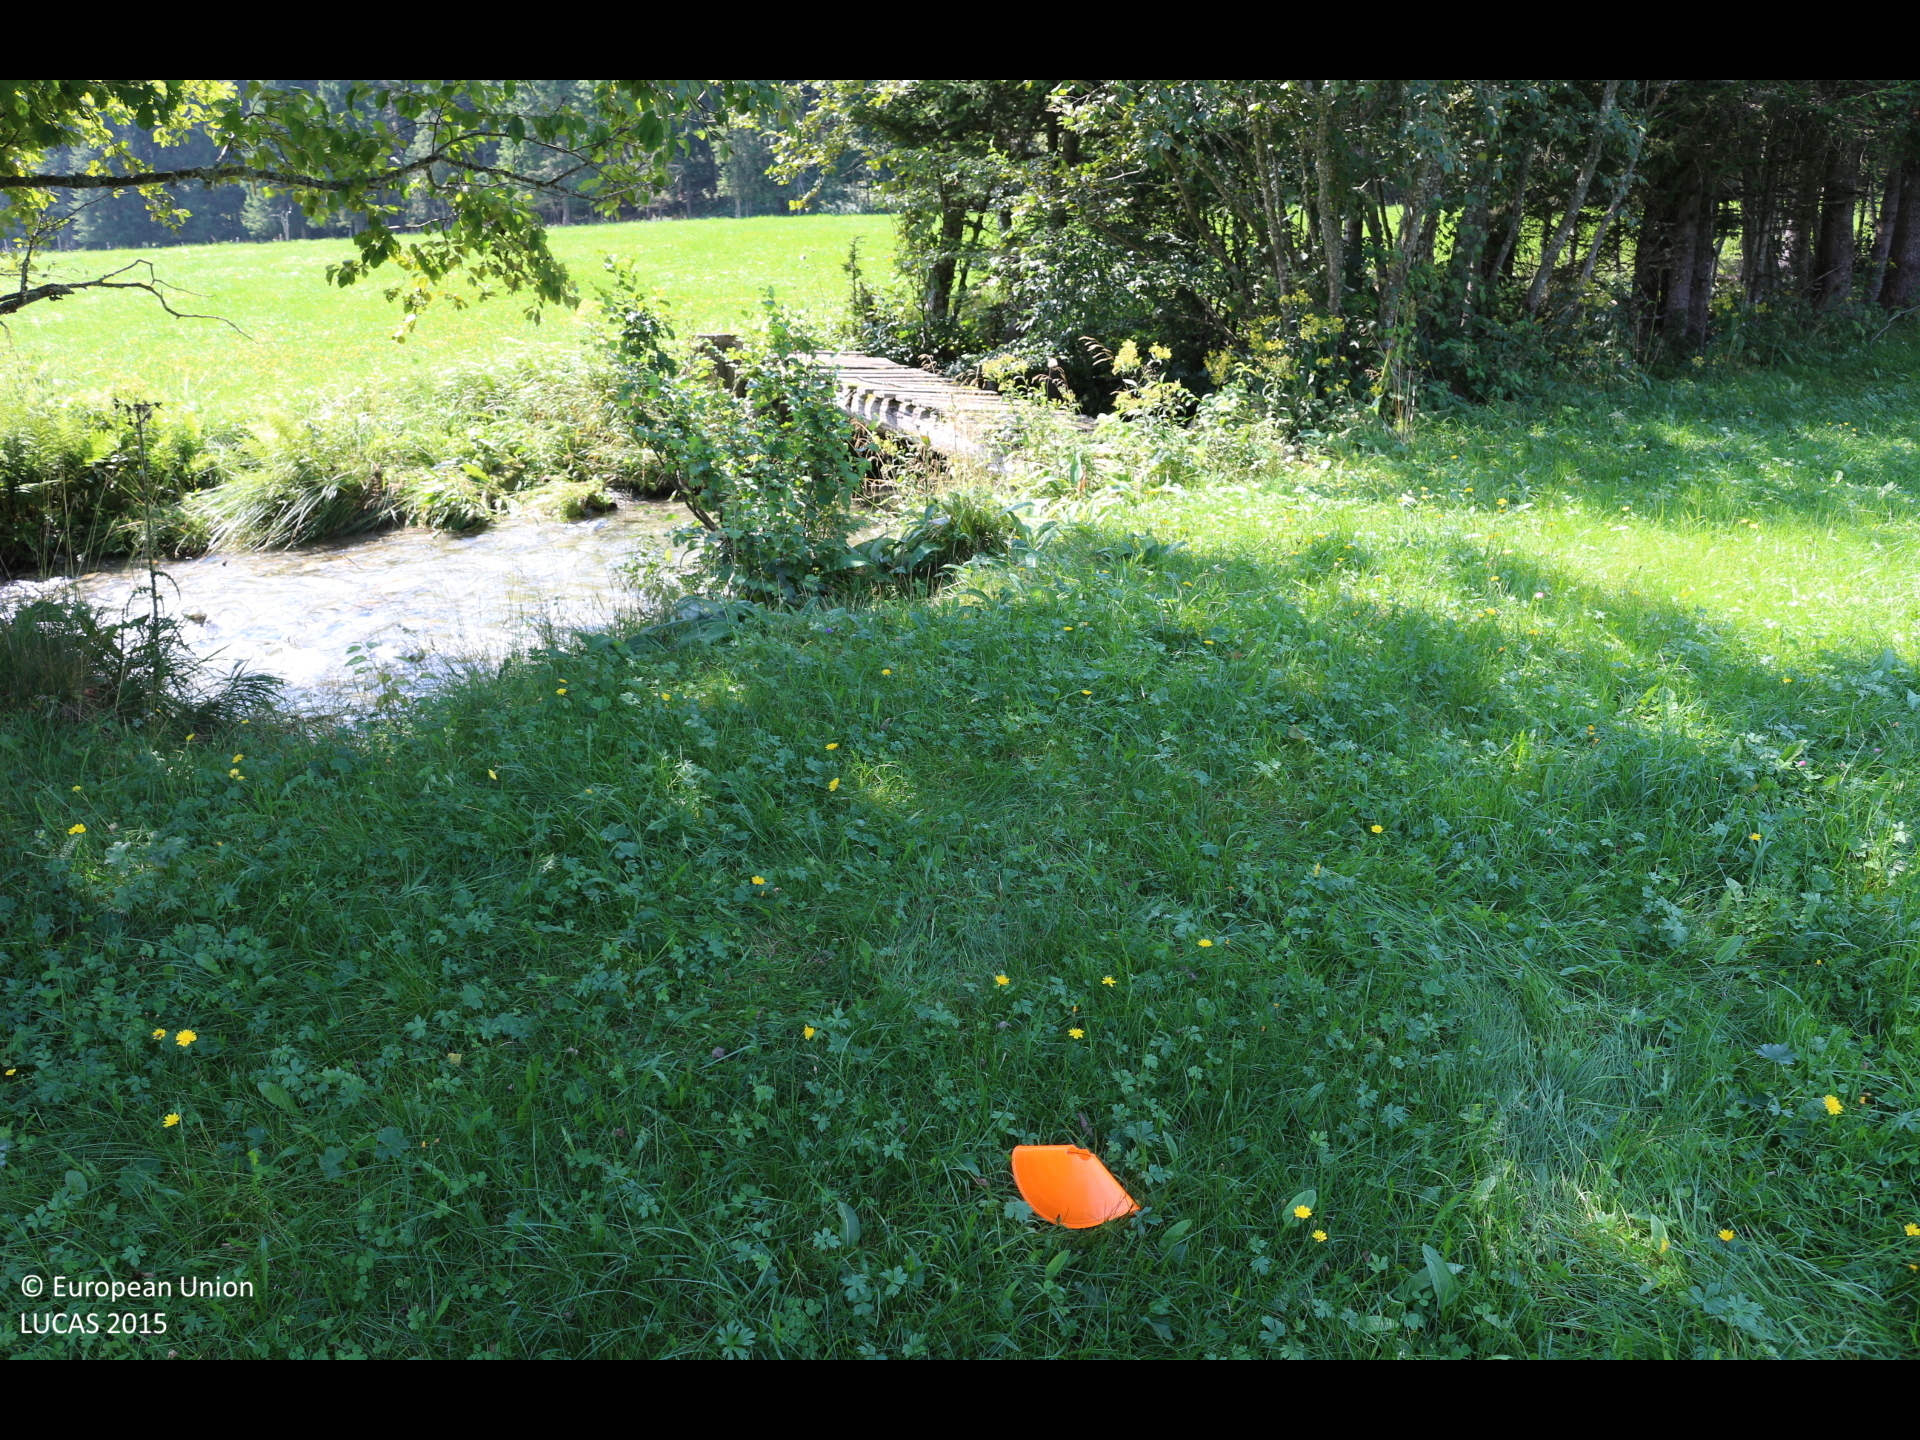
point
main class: Grassland
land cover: Grassland without tree/shrub cover
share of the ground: > 75 %
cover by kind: herbaceous plants 100 %
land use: Agriculture (excluding fallow land and kitchen gardens)
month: August
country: AT
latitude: 47.0283
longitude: 14.1428
